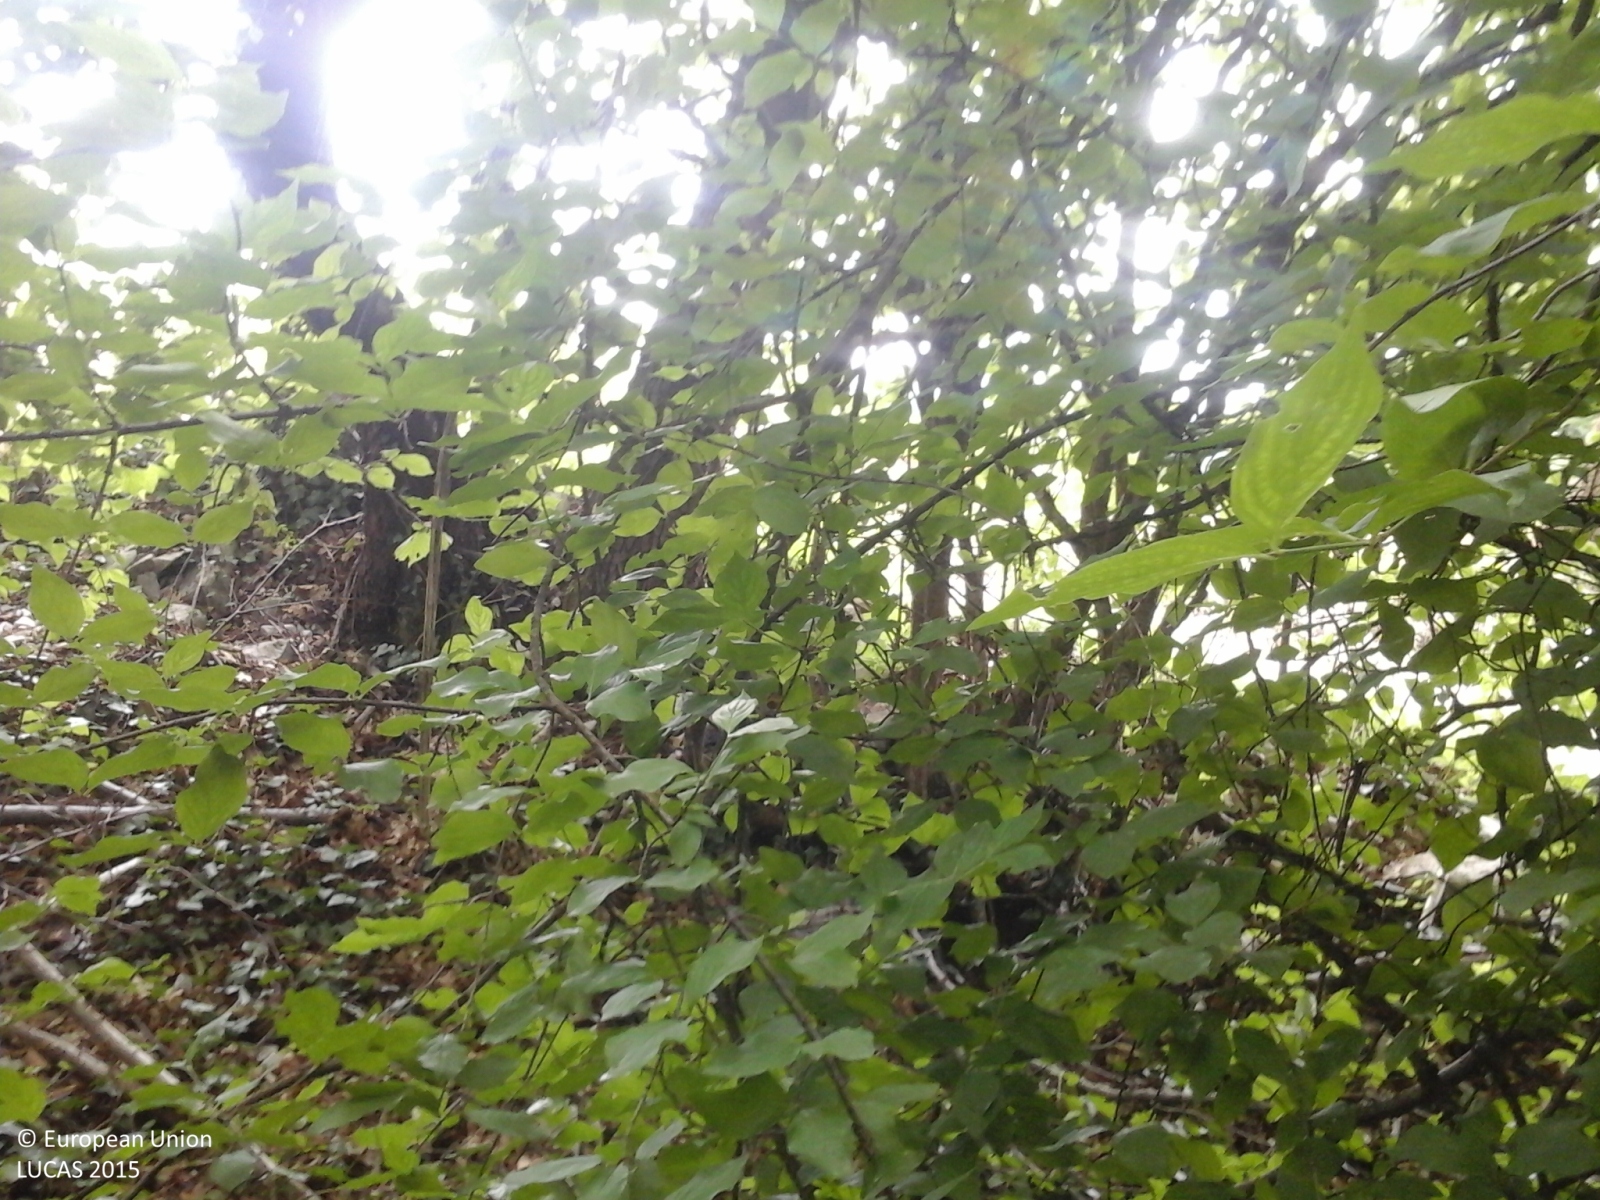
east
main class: Woodland
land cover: Broadleaved woodland
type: thermophilous deciduous forest
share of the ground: > 75 %
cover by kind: broadleaved forest trees 100 %
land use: Forestry
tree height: > 5 m
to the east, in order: Broadleaved woodland; Tracks; Grassland without tree/shrub cover; Abandoned hedges; Fences; Grassland without tree/shrub cover; Fences; Abandoned hedges; Grassland without tree/shrub cover; Shrubland with sparse tree cover; Broadleaved woodland
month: June
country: IT
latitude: 45.7817
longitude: 11.5283
